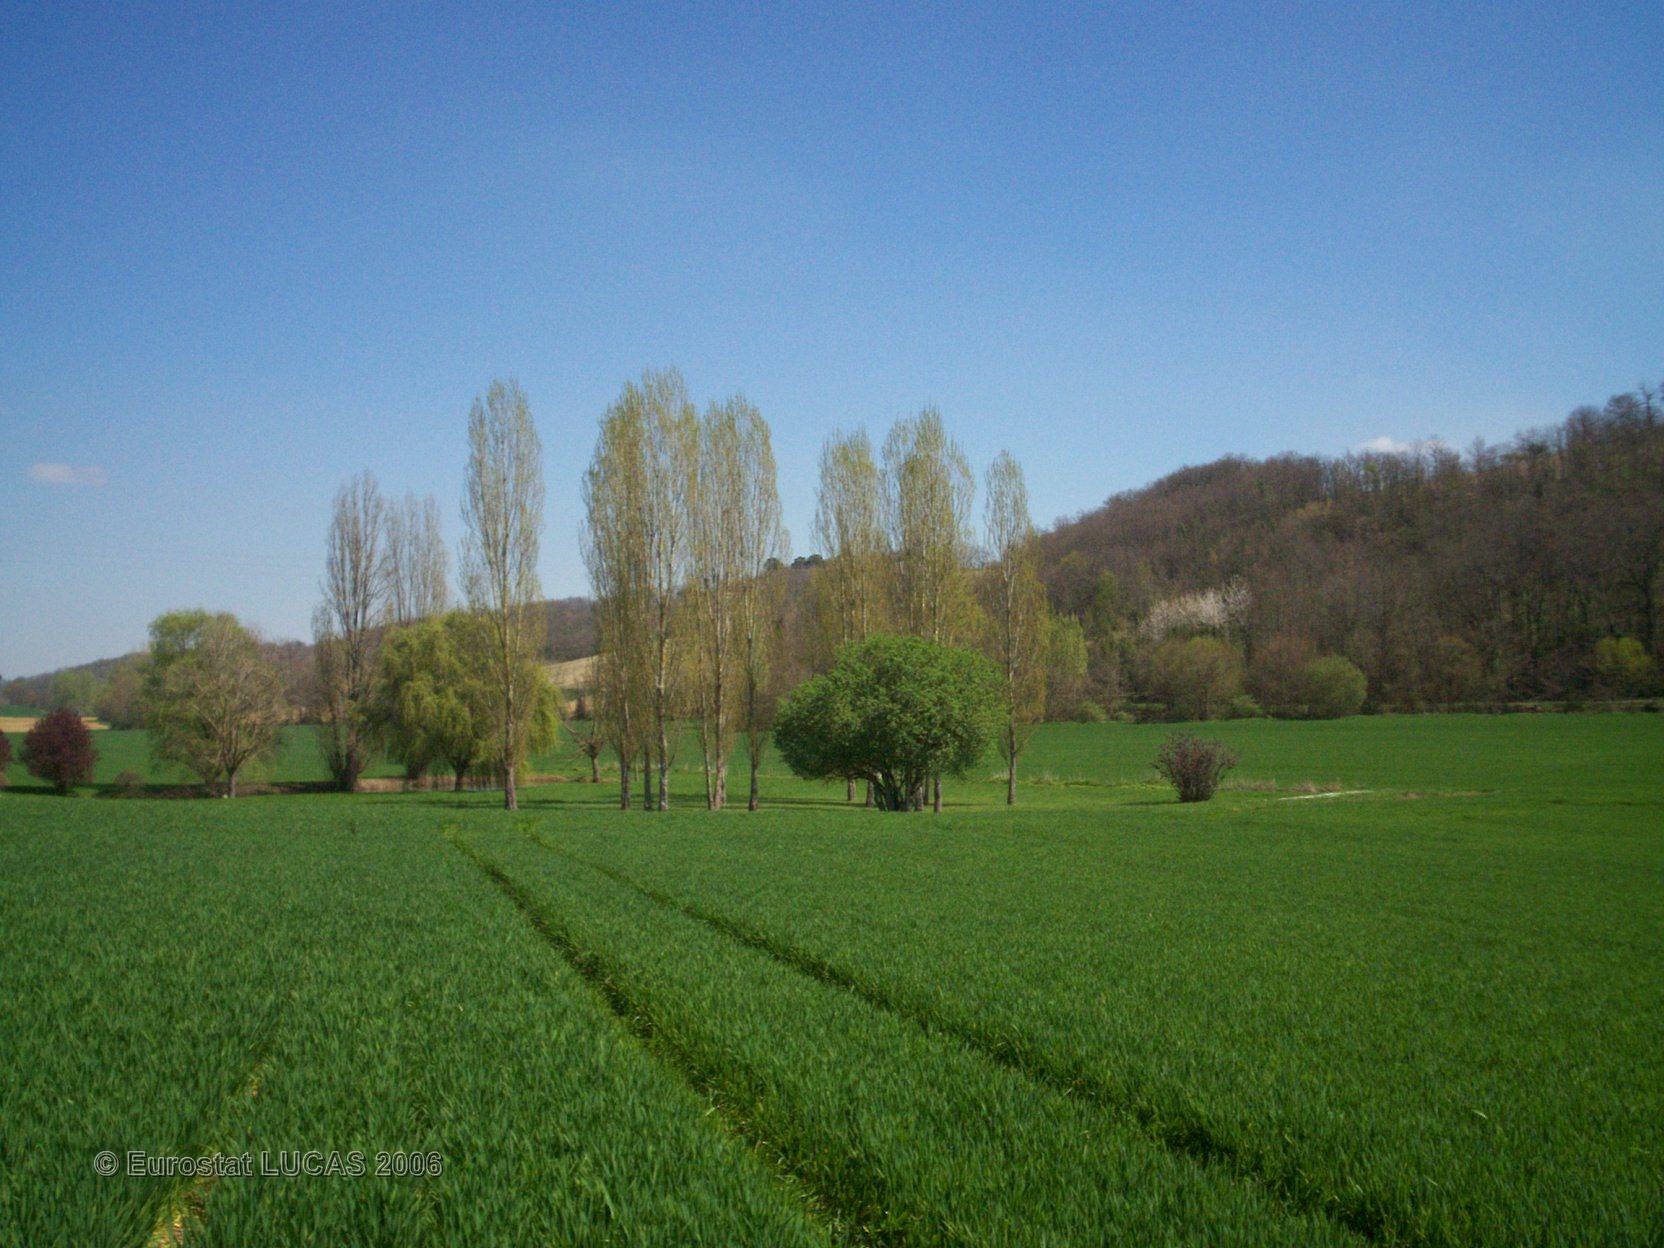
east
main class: Cropland
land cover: Common wheat
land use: Agriculture (excluding fallow land and kitchen gardens)
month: April
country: FR
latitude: 44.0407
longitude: 0.8998
